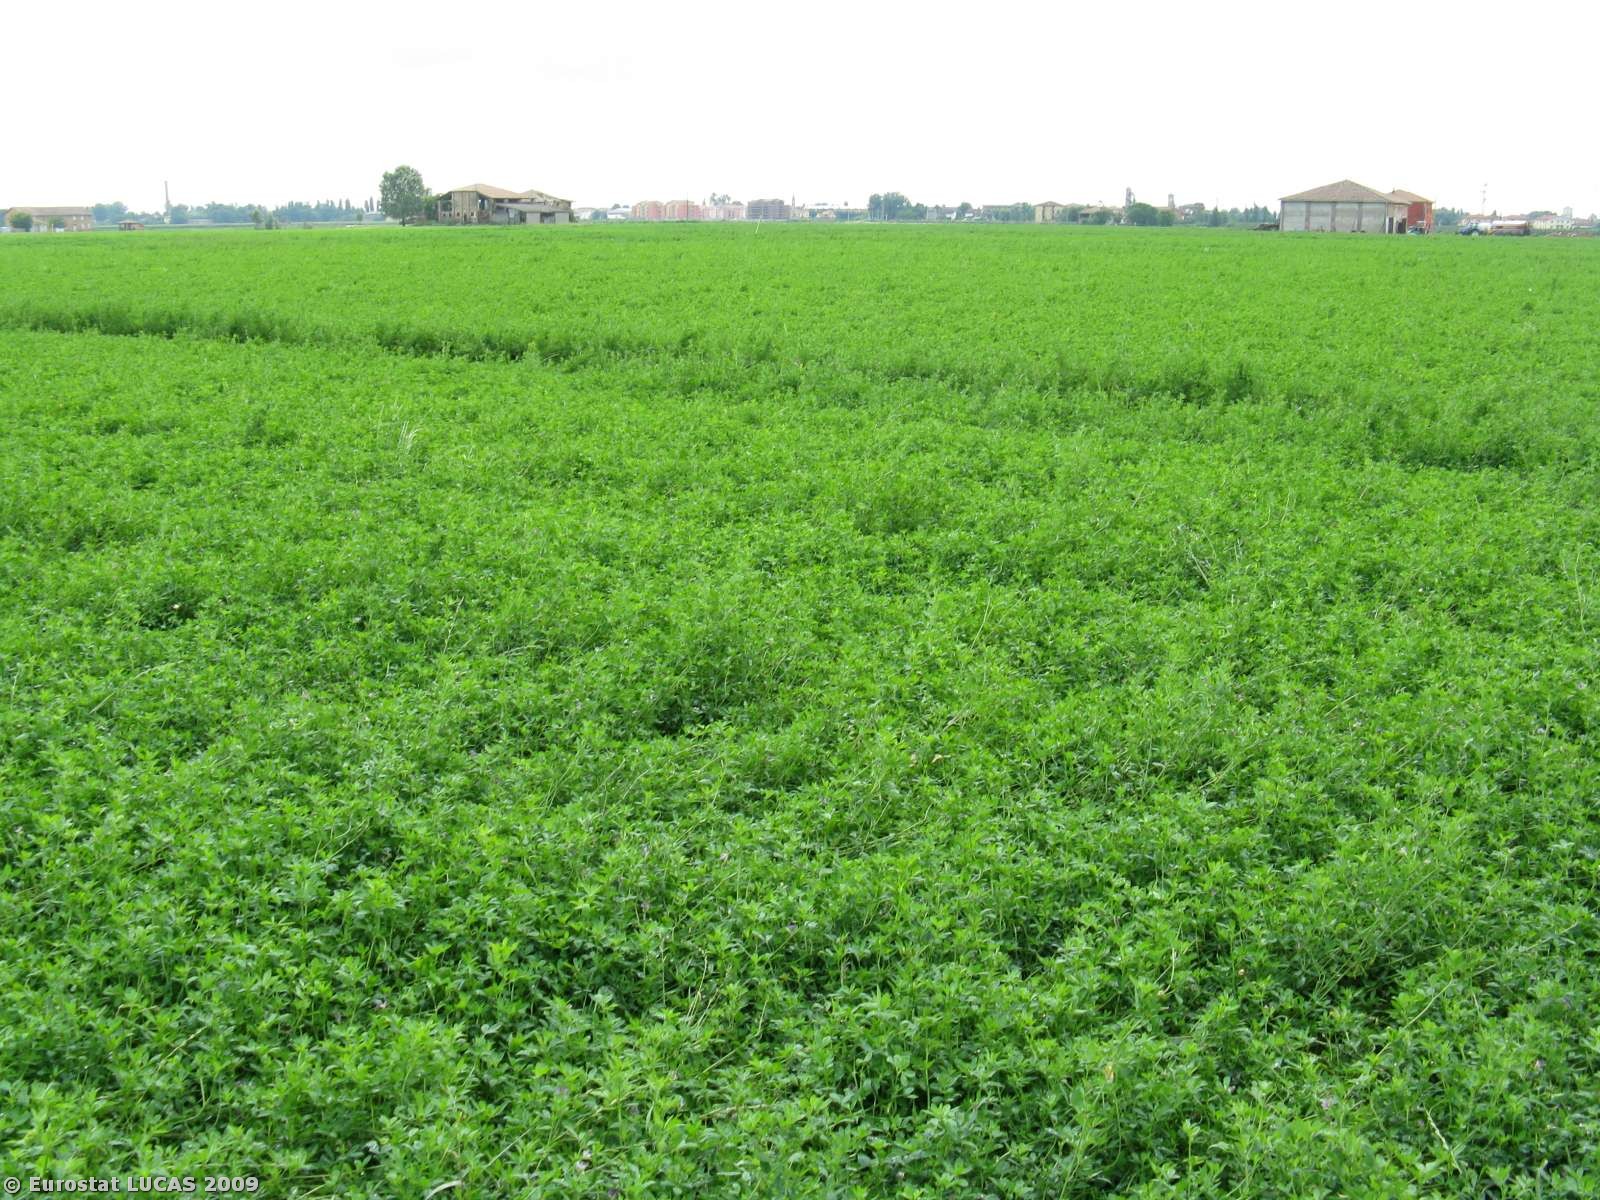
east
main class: Cropland
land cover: Lucerne
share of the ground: > 75 %
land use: Agriculture (excluding fallow land and kitchen gardens)
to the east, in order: Lucerne; Ditches and canals; Lucerne; Ditches and canals; Lucerne; Ditches and canals; Lucerne; Ditches and canals; Lucerne; Ditches and canals; Tracks; Ditches and canals; Lucerne
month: July
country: IT
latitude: 44.6261
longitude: 11.6477
